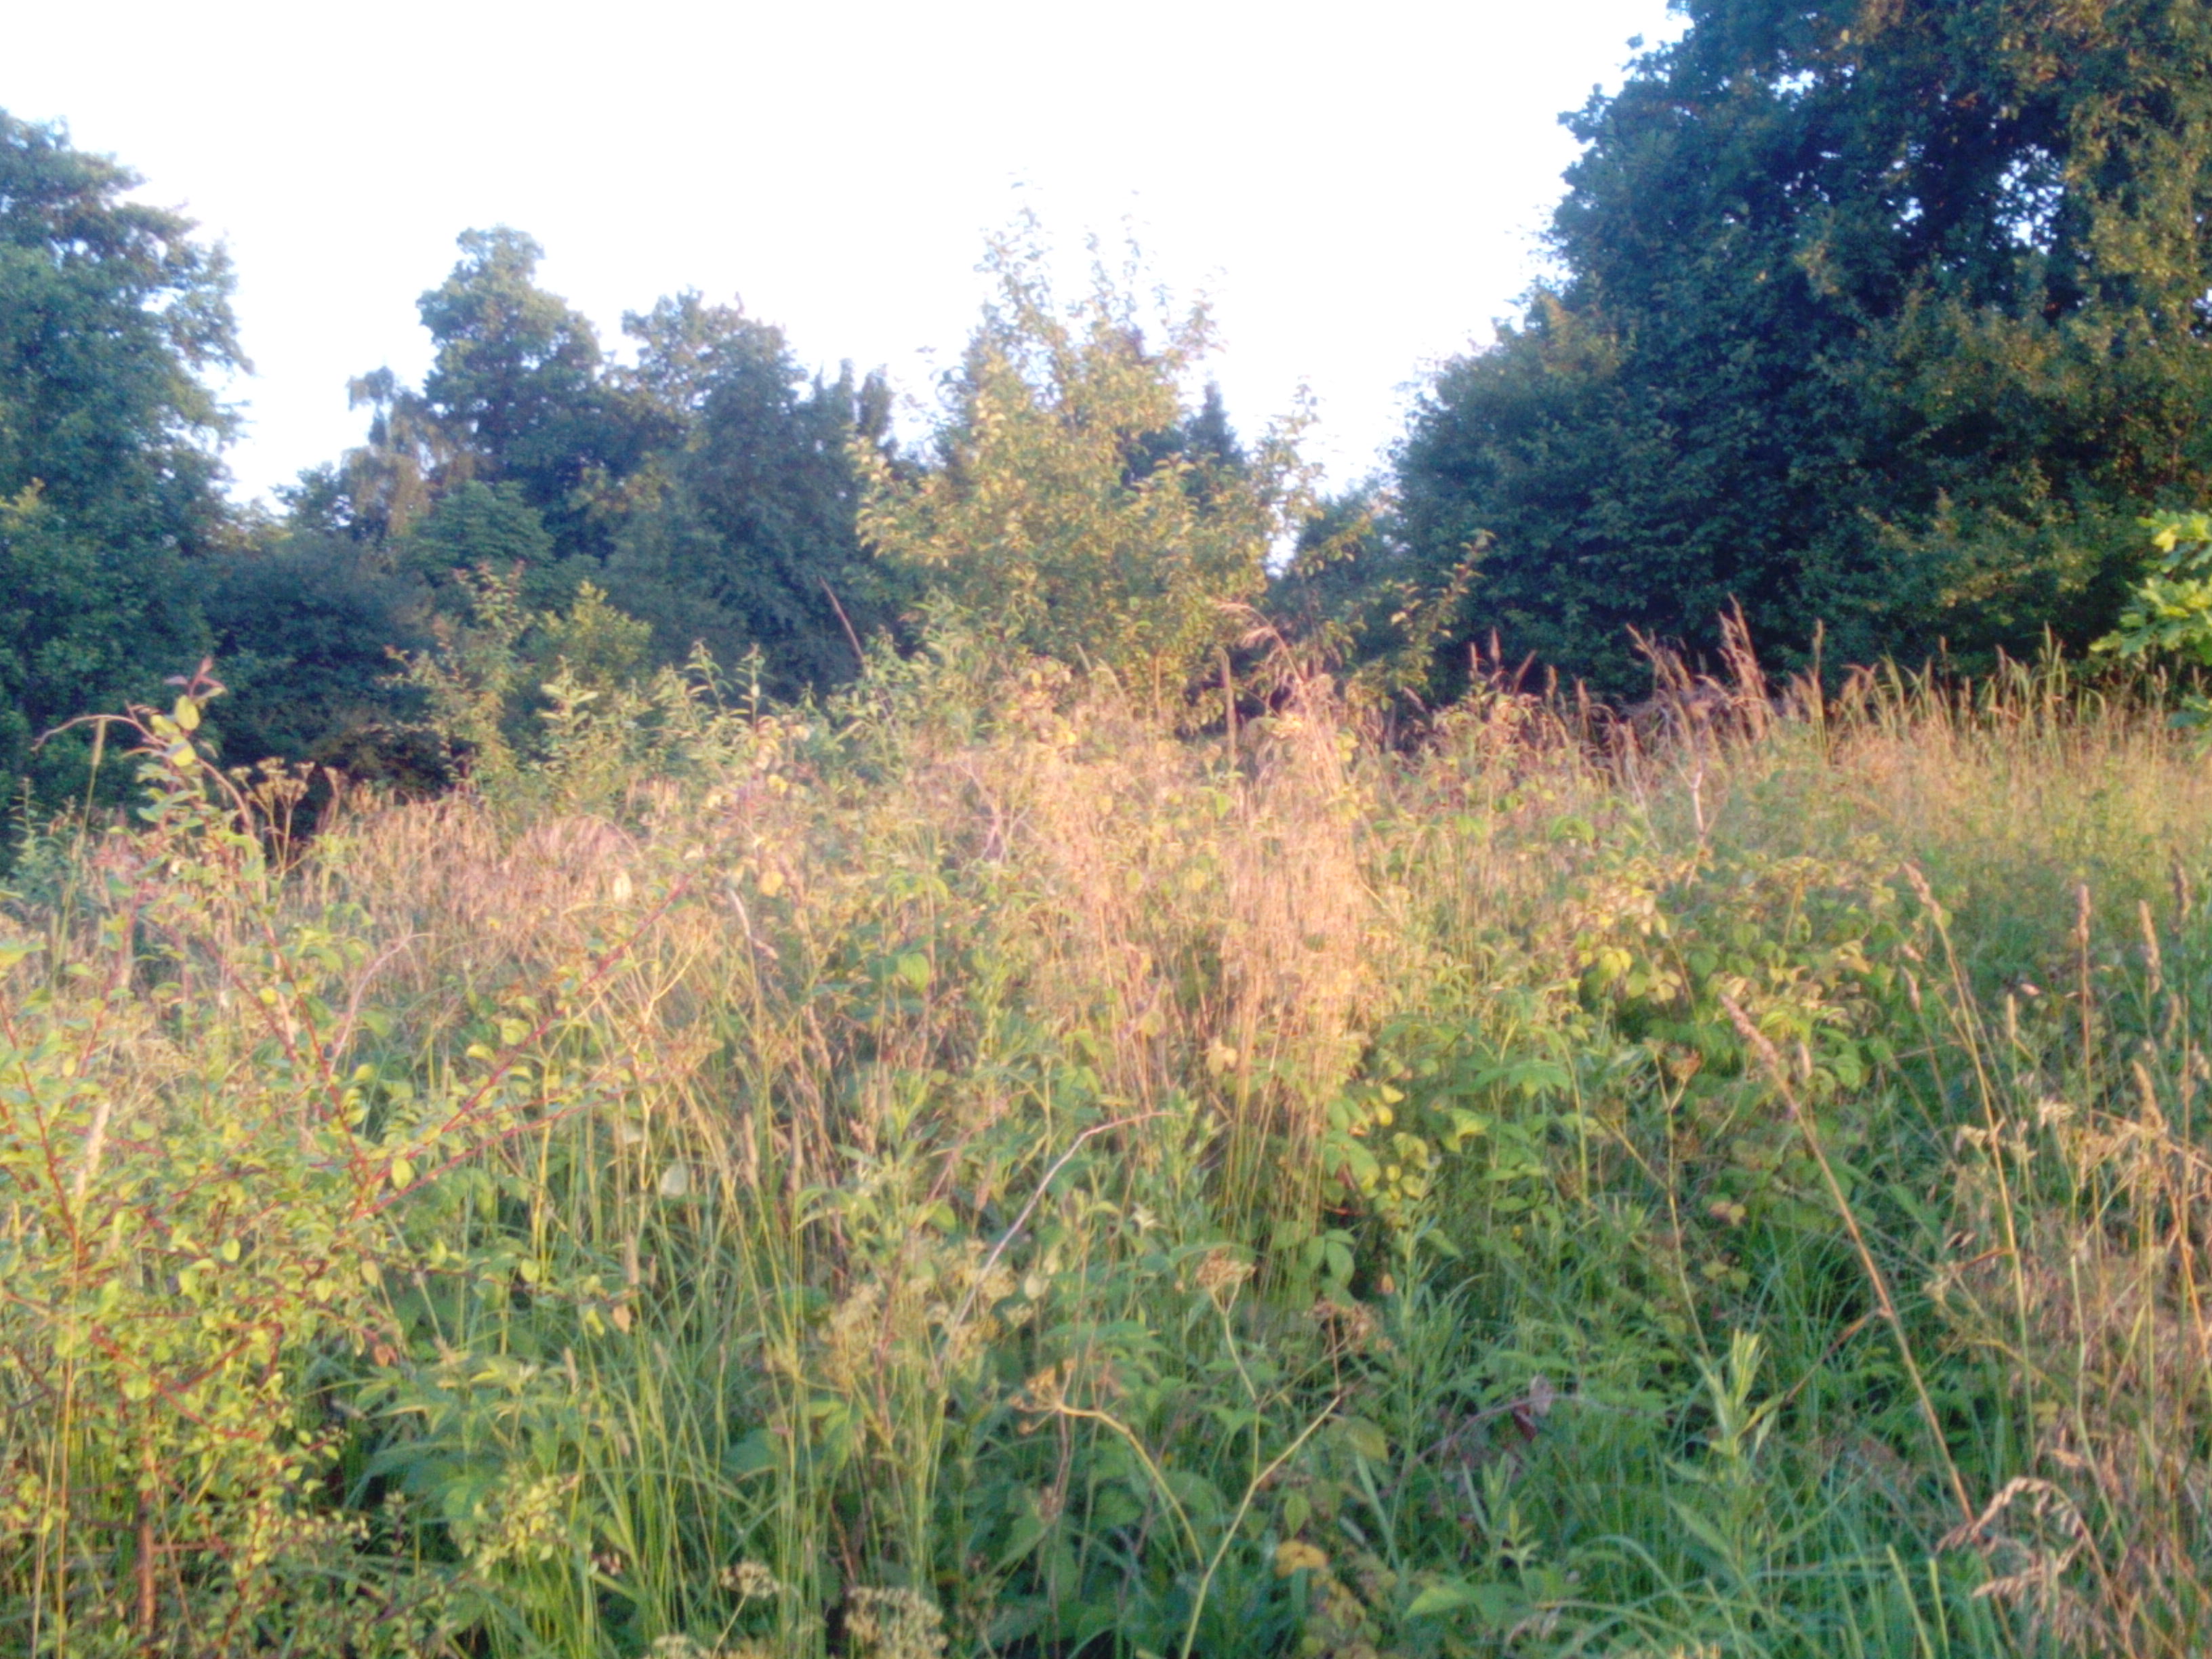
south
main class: Grassland
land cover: Spontaneously vegetated surfaces
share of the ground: > 75 %
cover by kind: herbaceous plants 90 %
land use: Semi-natural and natural areas not in use
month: July
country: LV
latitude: 56.3526
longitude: 21.7791
